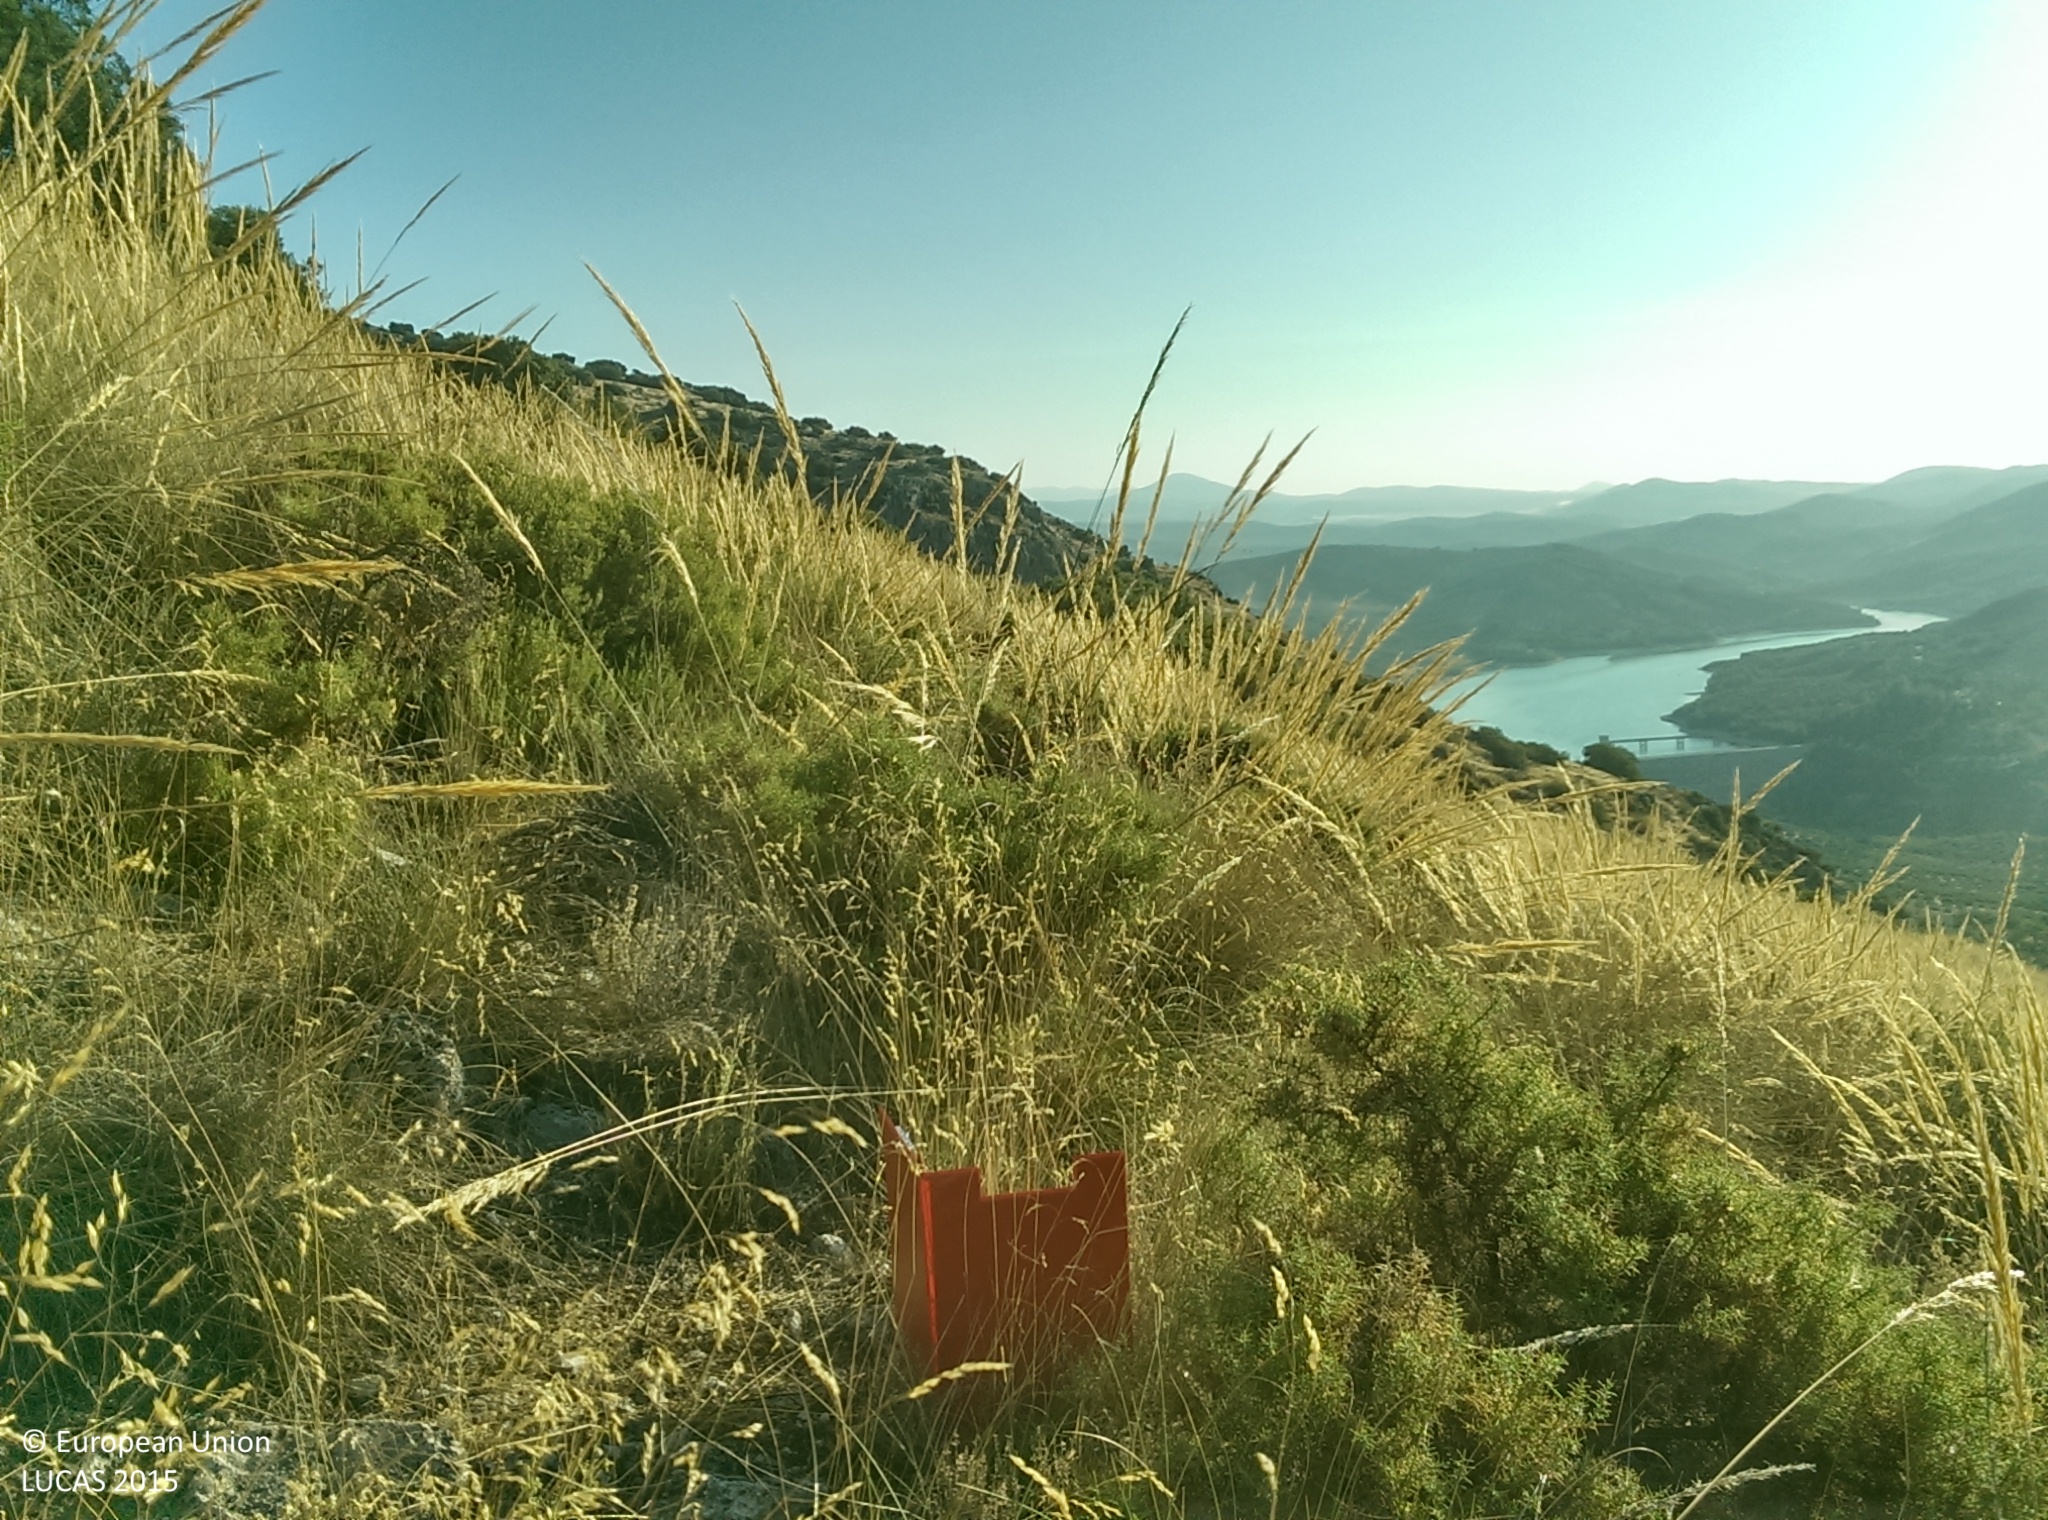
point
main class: Shrubland
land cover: Shrubland without tree cover
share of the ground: 10 - 25 %
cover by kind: herbaceous plants 85 %, shrubs 10 %, consolidated bare surface 5 %
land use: Semi-natural and natural areas not in use
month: July
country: ES
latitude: 37.3879
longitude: -3.7396
